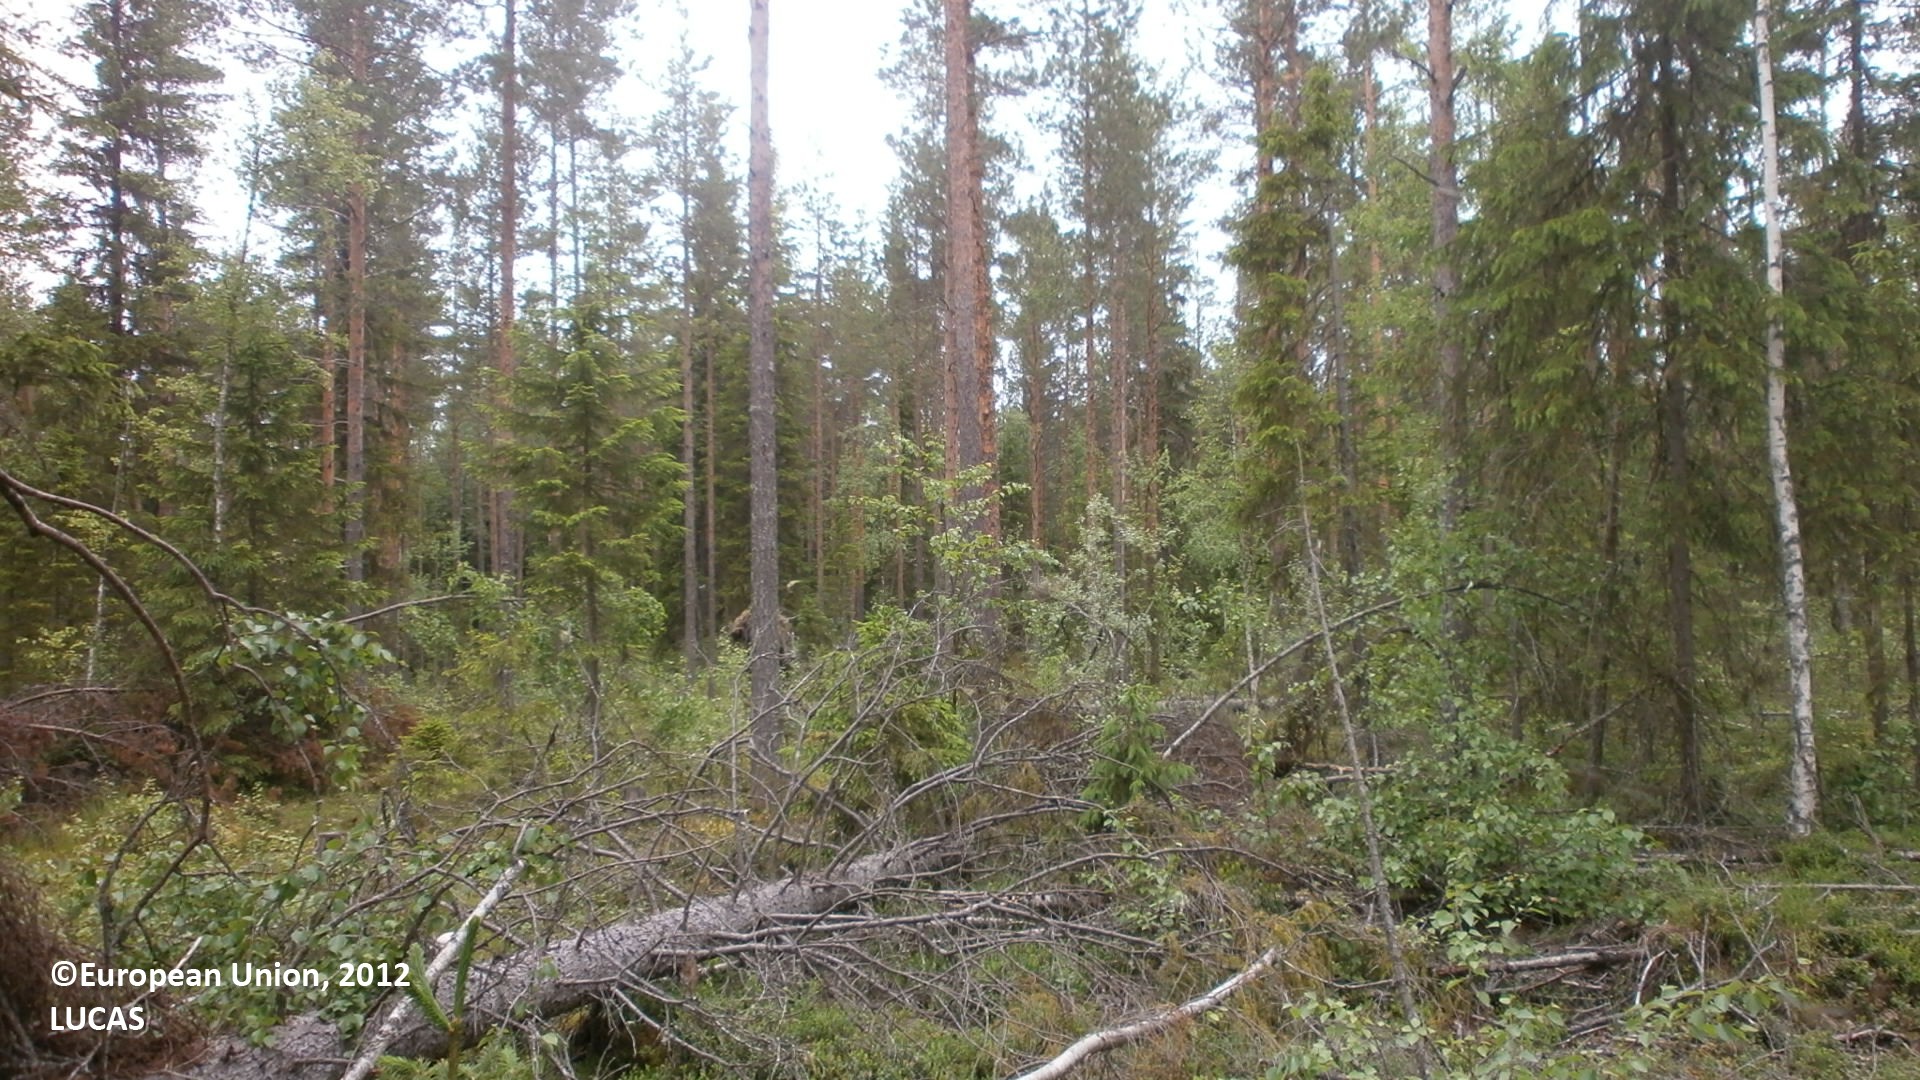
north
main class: Woodland
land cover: Other coniferous woodland
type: boreal forest
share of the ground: 50 - 75 %
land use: Forestry
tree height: > 5 m
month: June
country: FI
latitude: 64.2119
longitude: 25.7779
